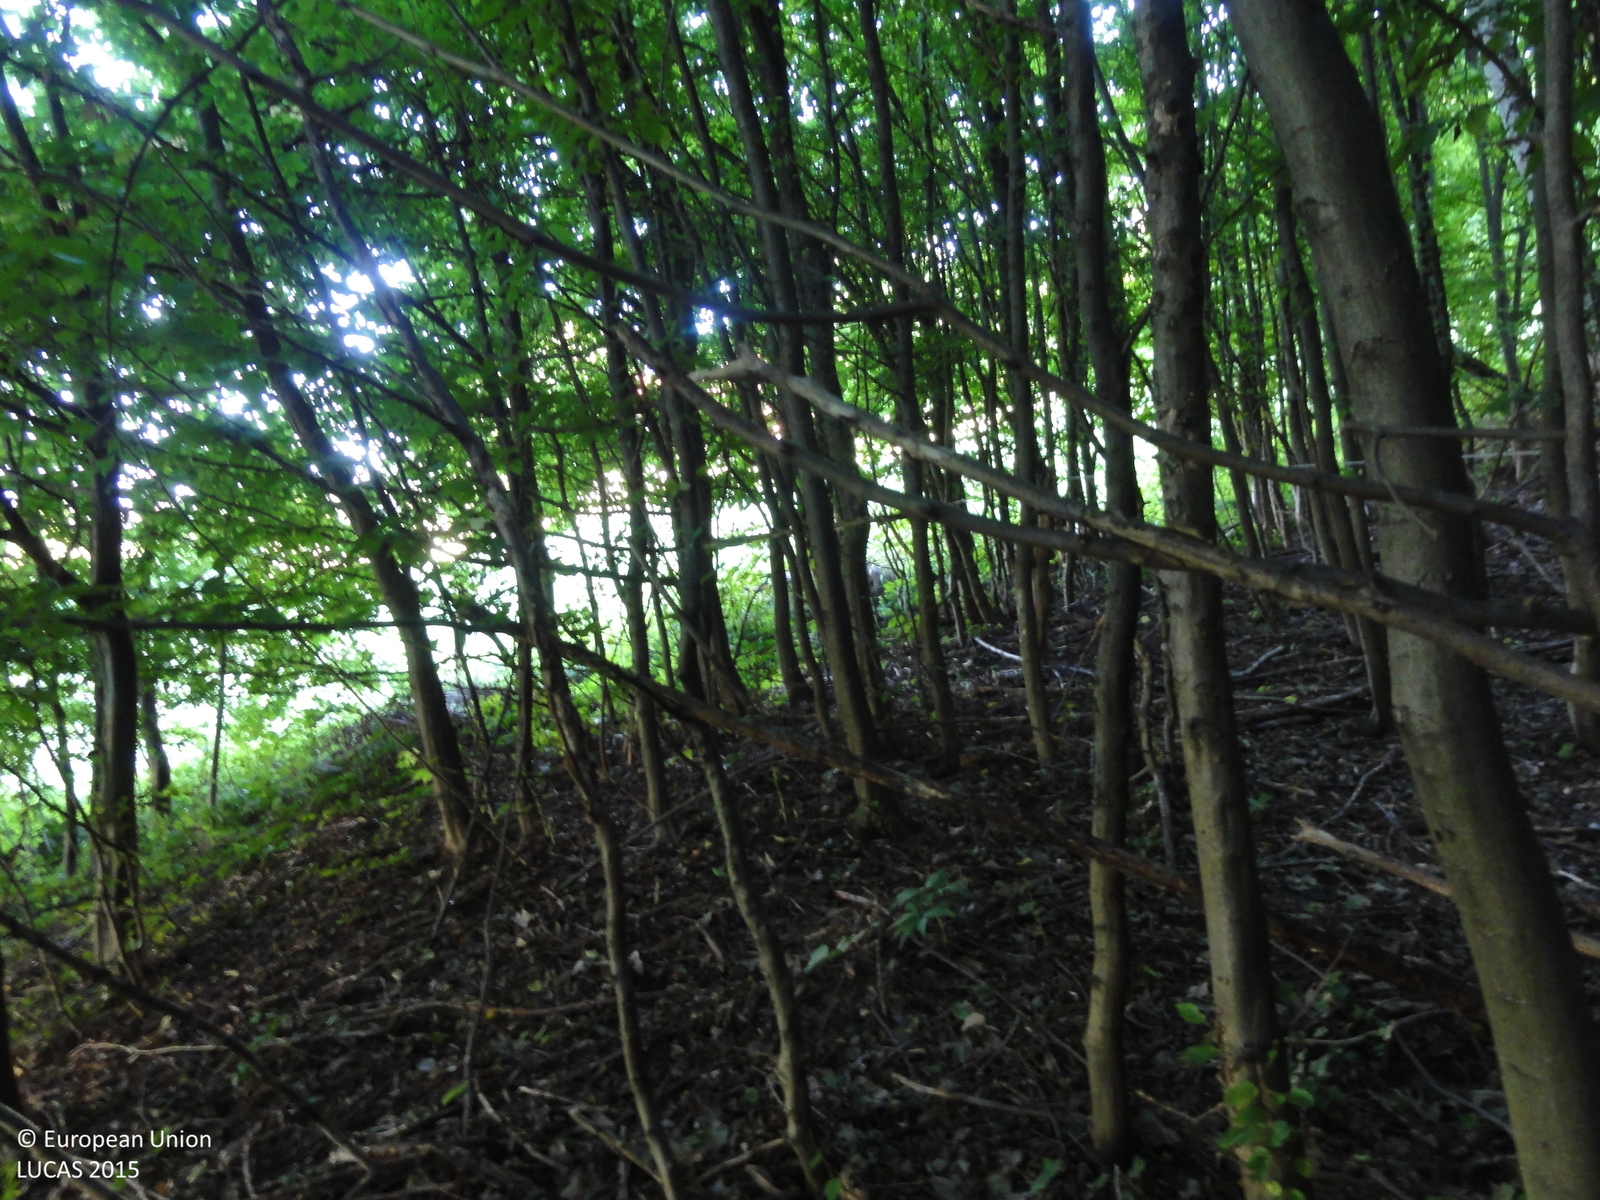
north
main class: Woodland
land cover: Broadleaved woodland
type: mesophytic deciduous forest
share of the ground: > 75 %
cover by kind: broadleaved forest trees 100 %
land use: Forestry
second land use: Amenities, museums, leisure
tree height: > 5 m
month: July
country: SI
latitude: 46.3222
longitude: 15.0499
